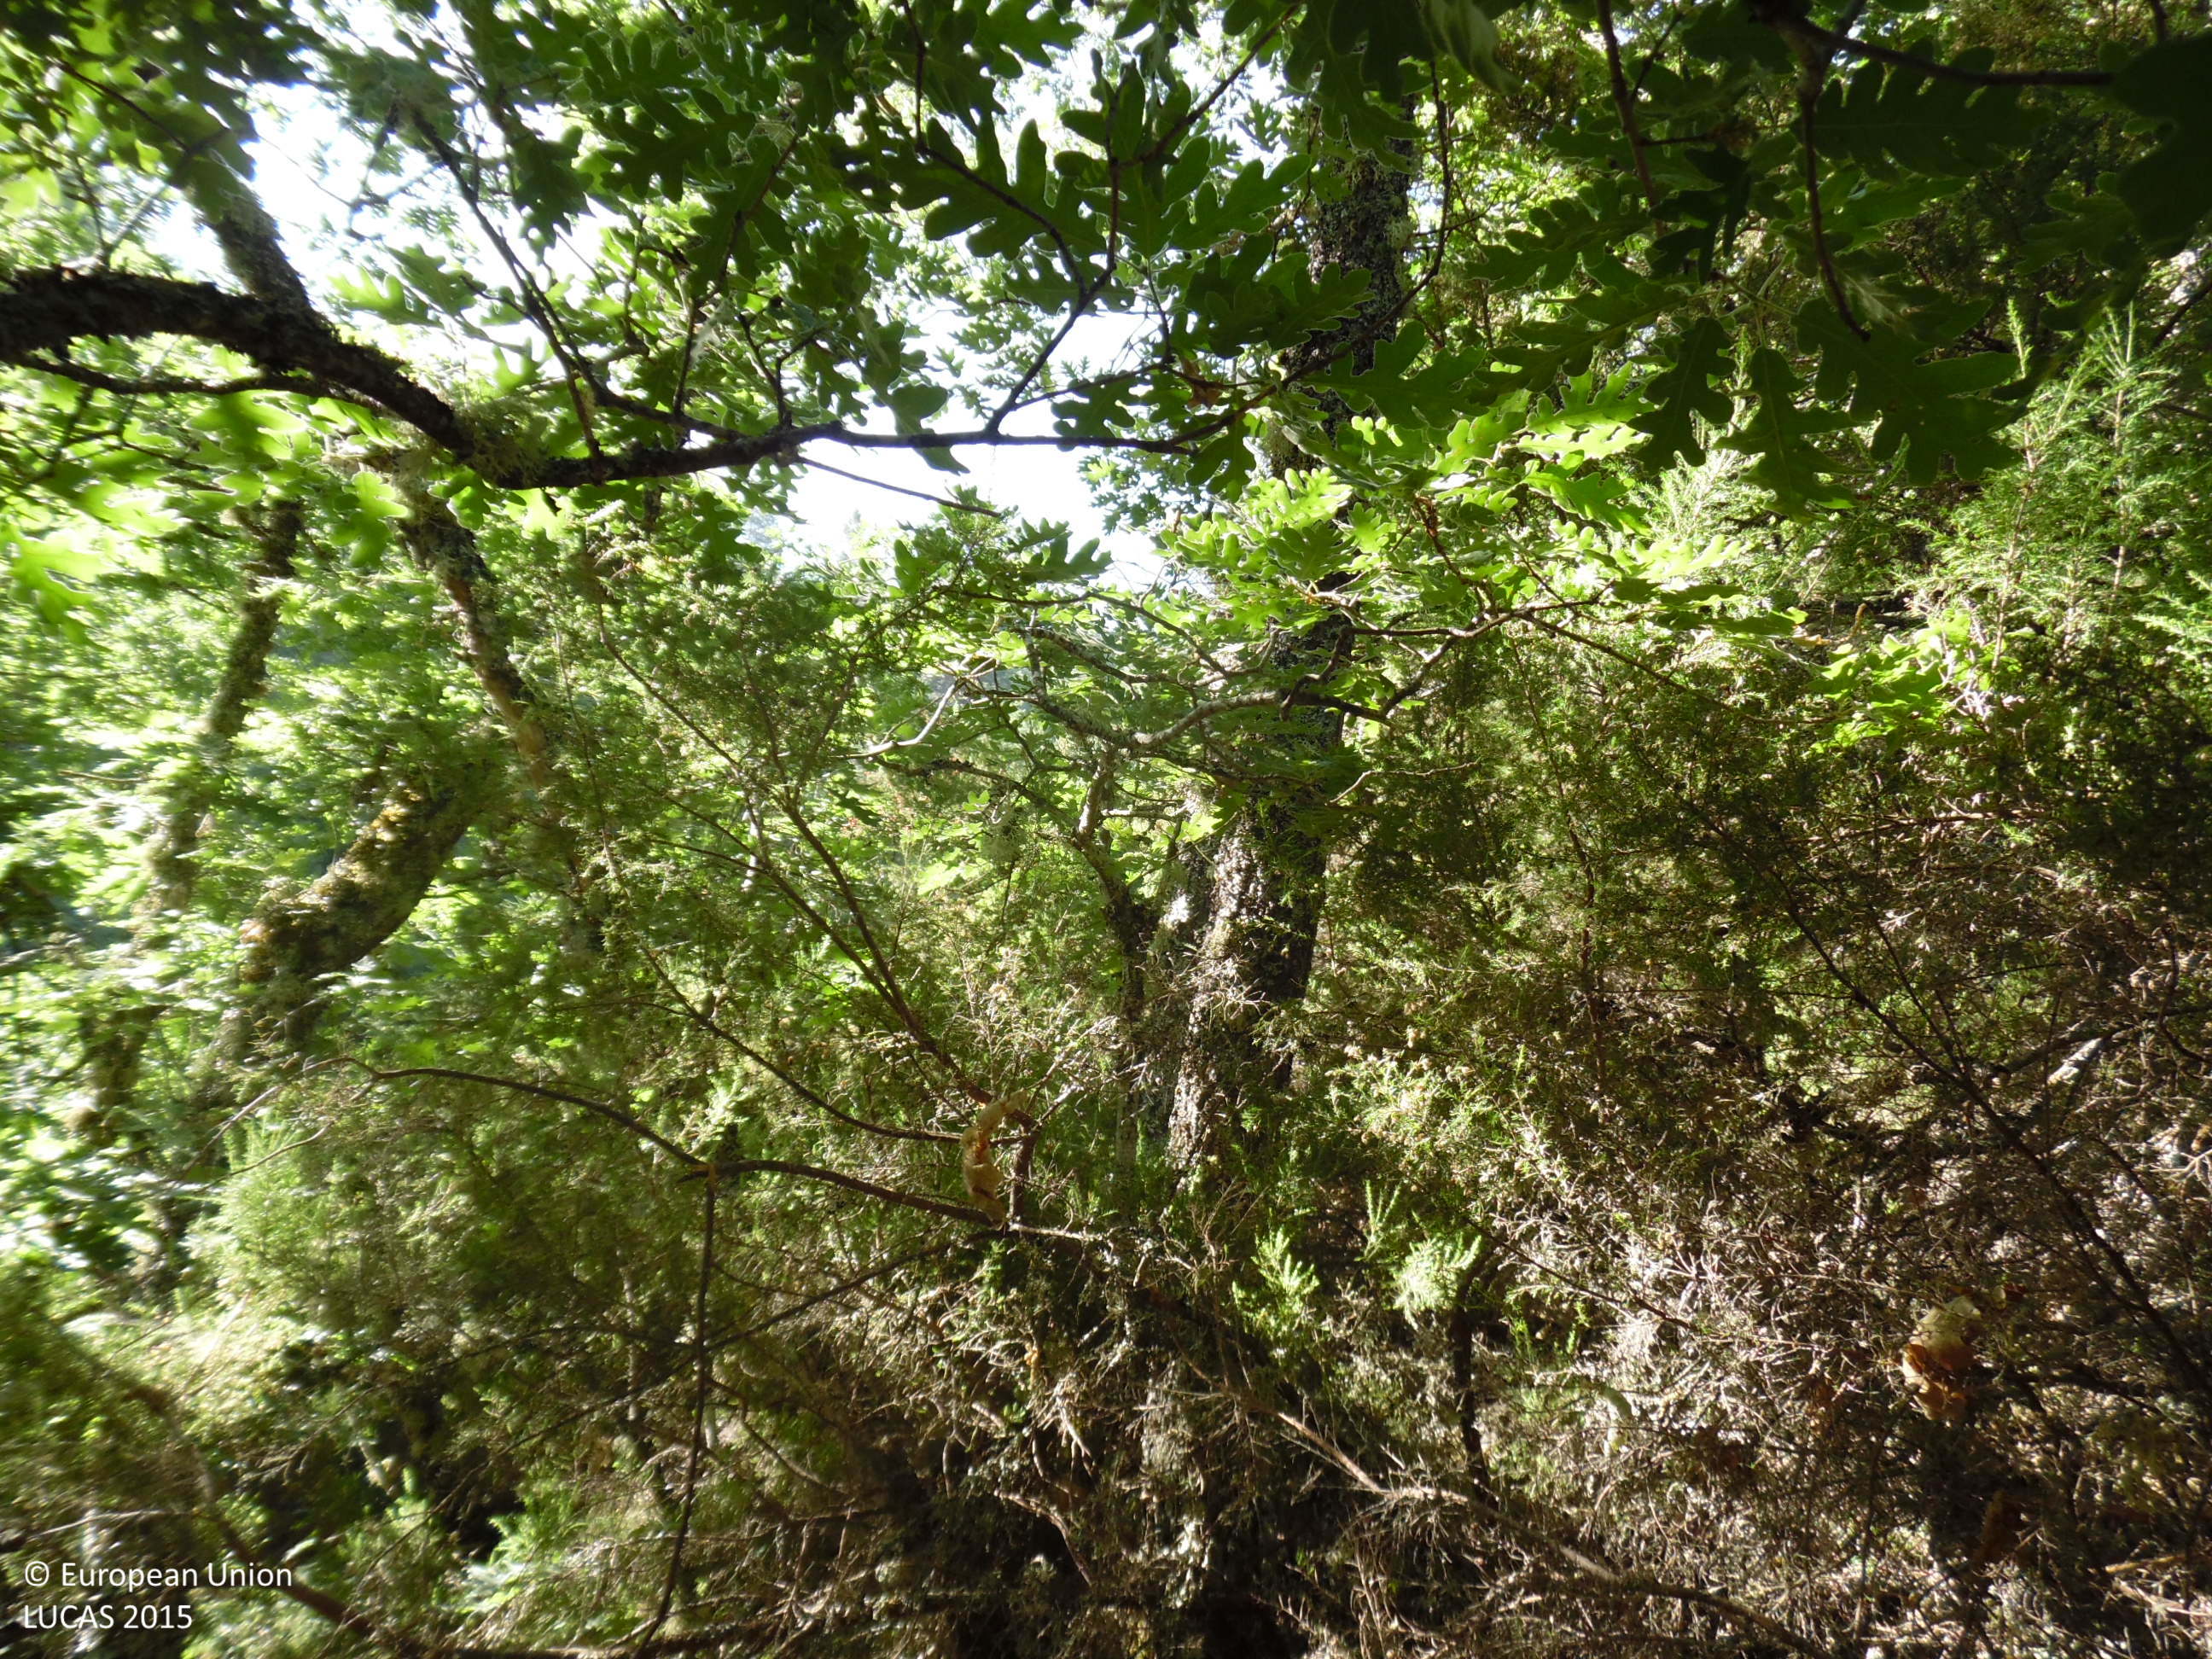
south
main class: Woodland
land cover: Broadleaved woodland
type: thermophilous deciduous forest
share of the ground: > 75 %
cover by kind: broadleaved forest trees 95 %, shrubs 5 %
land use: Forestry
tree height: < 5 m
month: June
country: ES
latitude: 42.8381
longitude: -5.6771
